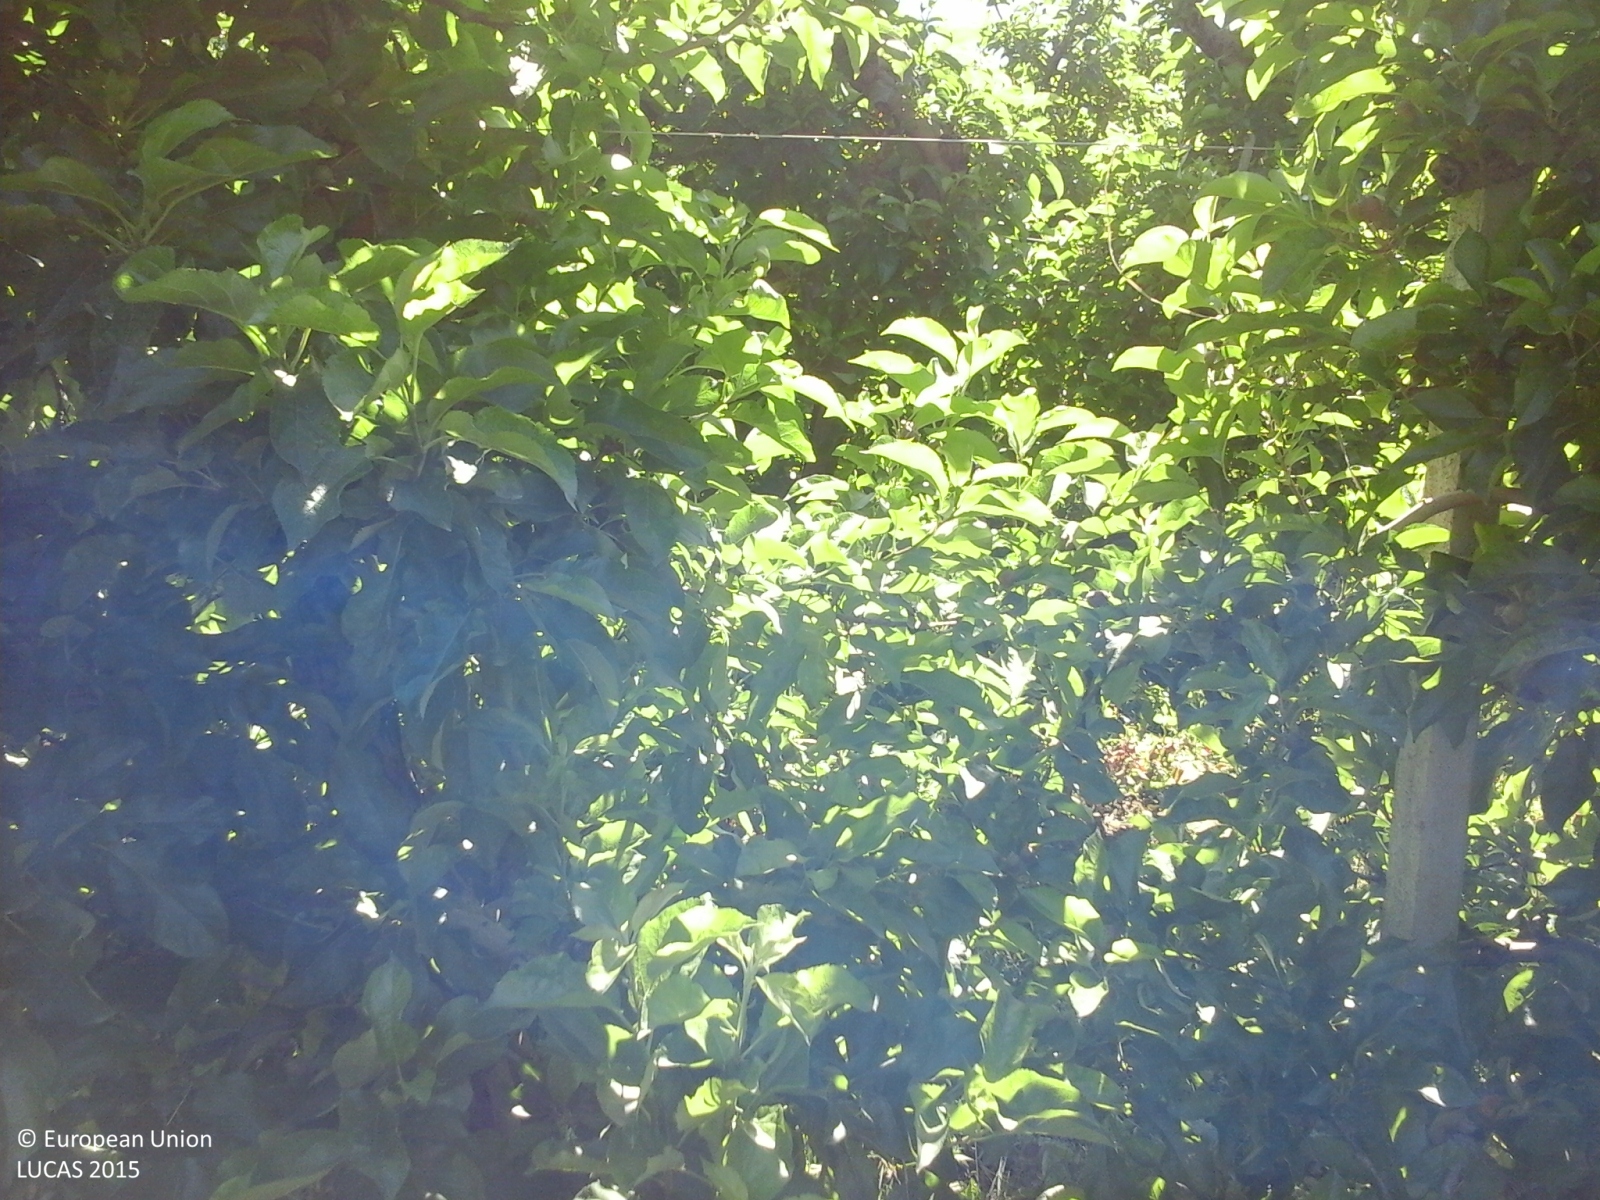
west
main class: Cropland
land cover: Apple fruit
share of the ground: > 75 %
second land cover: Grassland without tree/shrub cover
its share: > 75 %
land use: Agriculture (excluding fallow land and kitchen gardens)
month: May
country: IT
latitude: 46.6178
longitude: 10.8739
